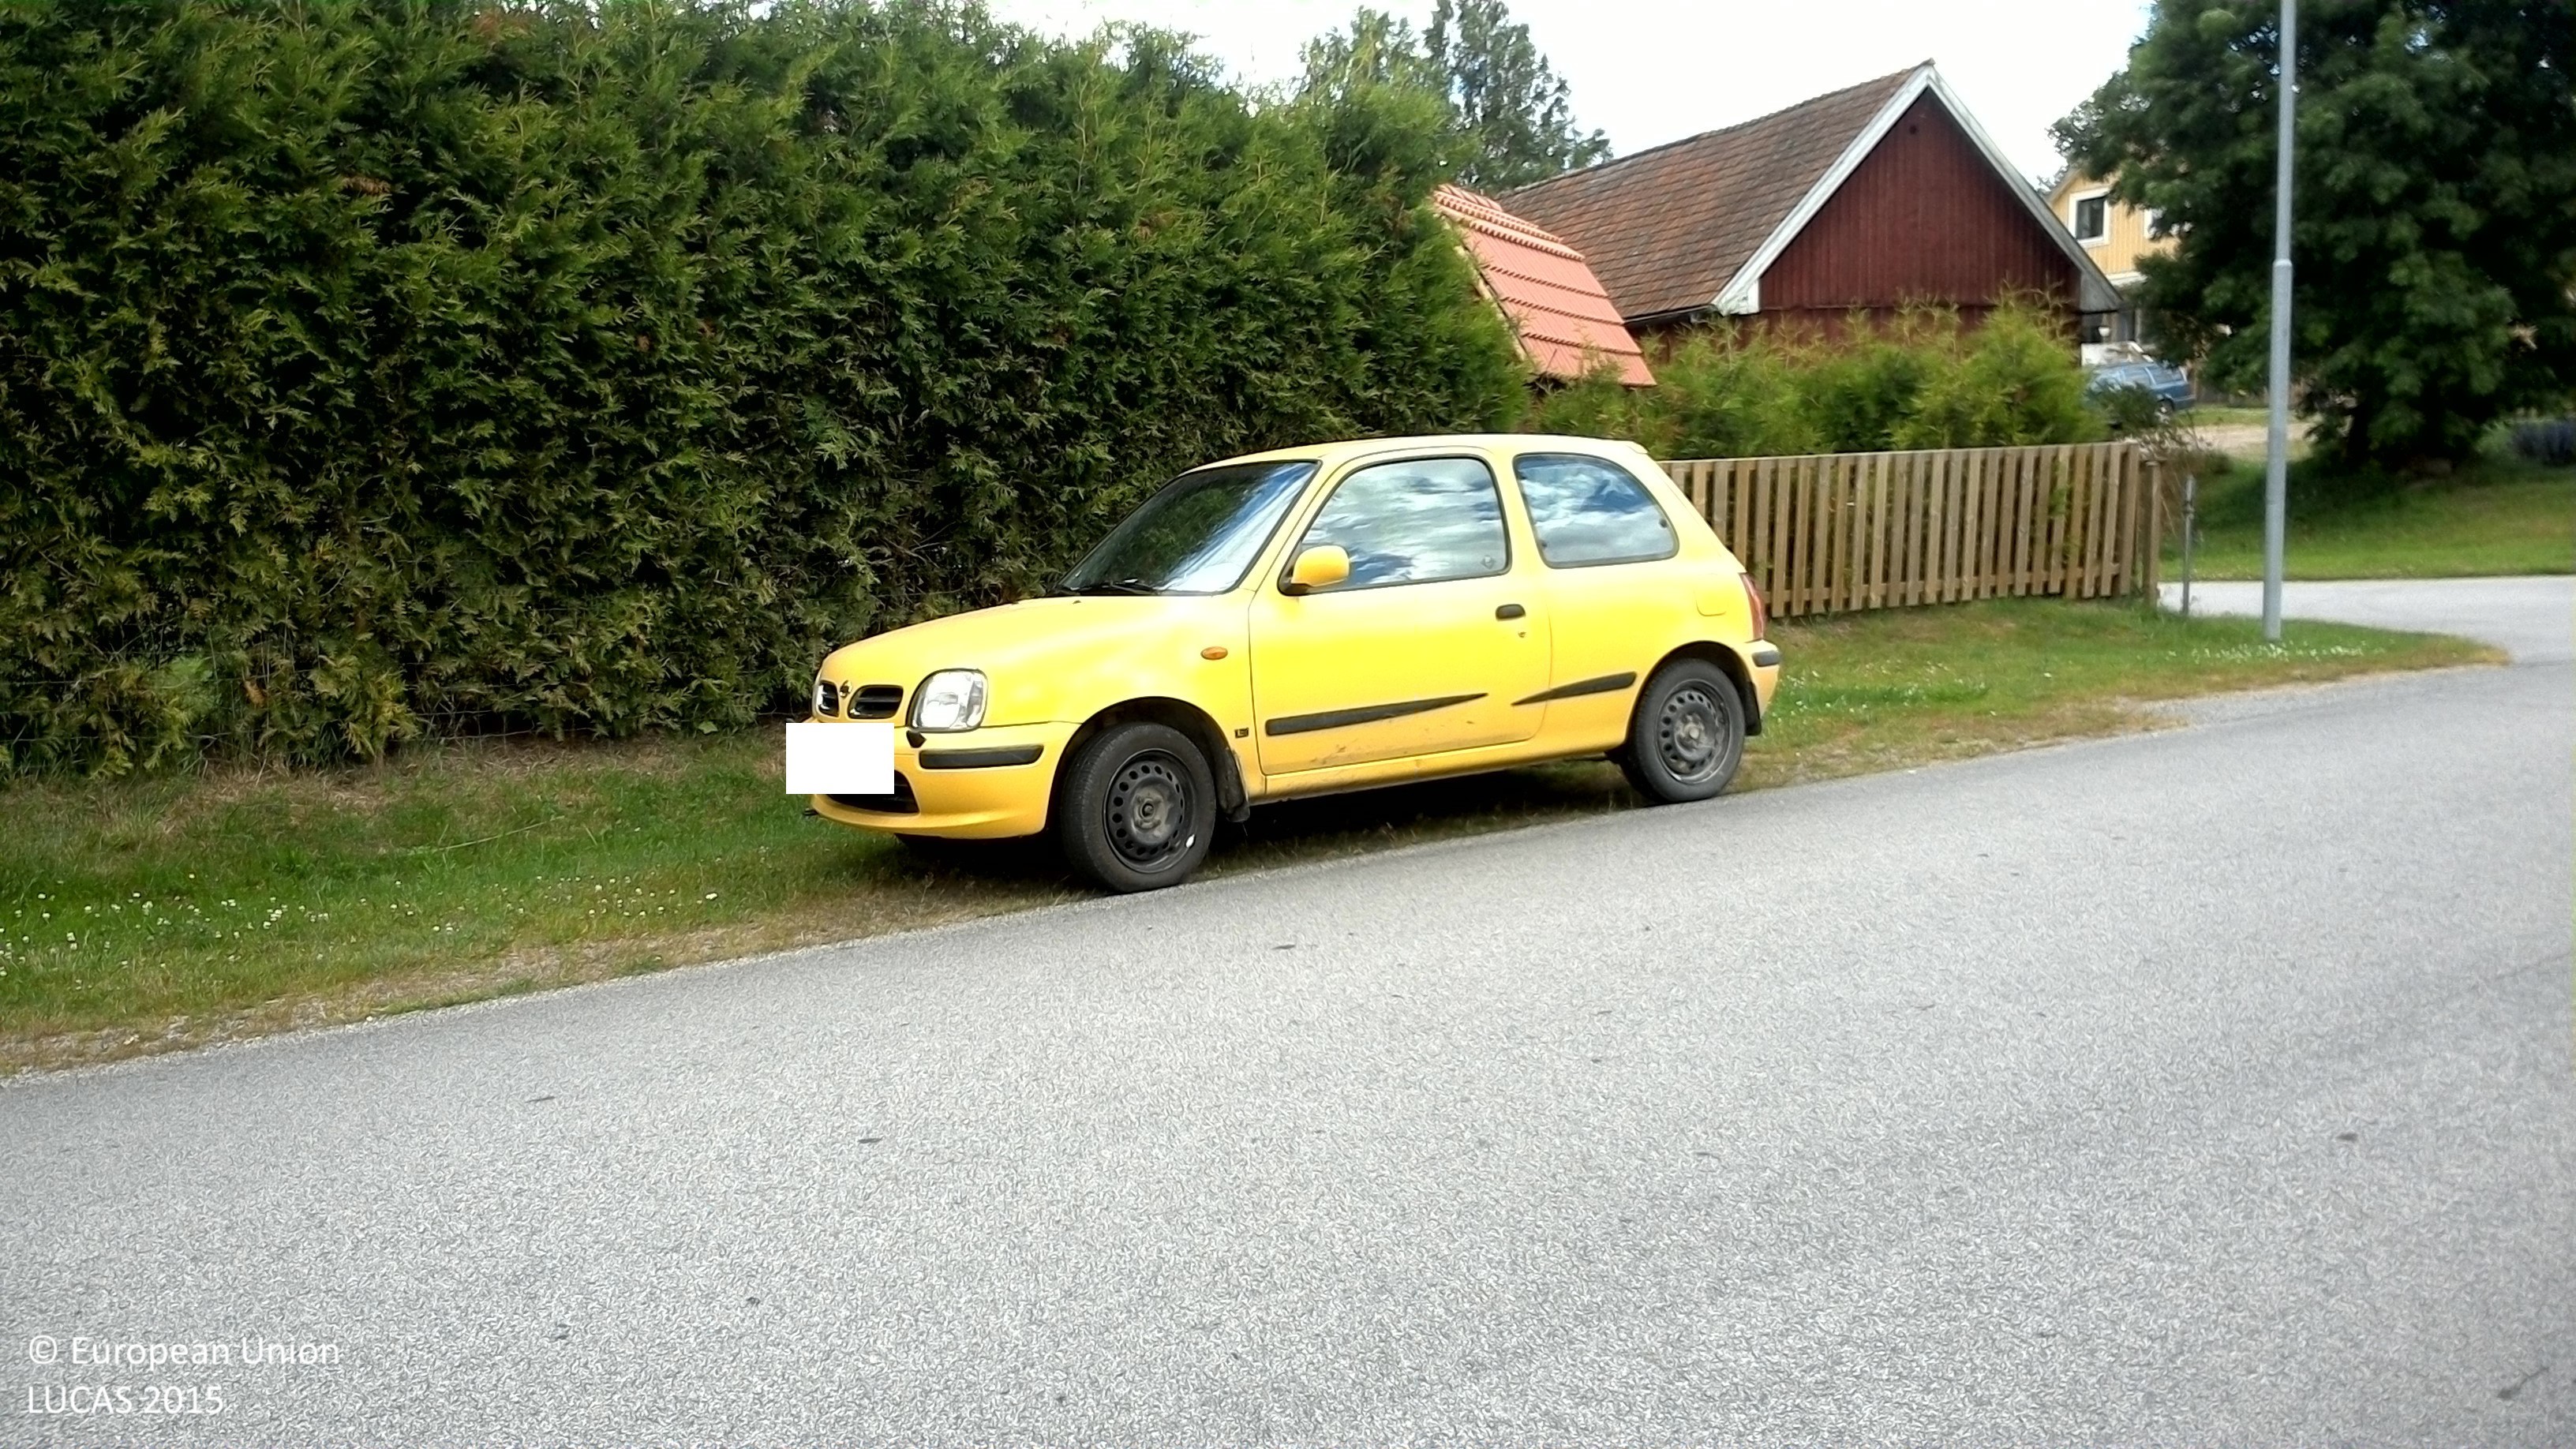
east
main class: Grassland
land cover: Grassland with sparse tree/shrub cover
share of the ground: > 75 %
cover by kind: herbaceous plants 85 %, shrubs 10 %, broadleaved forest trees 5 %
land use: Residential
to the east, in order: Grassland with sparse tree/shrub cover; Artificial constructions in urban areas; Broadleaved woodland; Inland fresh running water; Broadleaved woodland; Other leguminous and mixtures for fodder
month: July
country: SE
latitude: 56.3927
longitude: 15.1013
